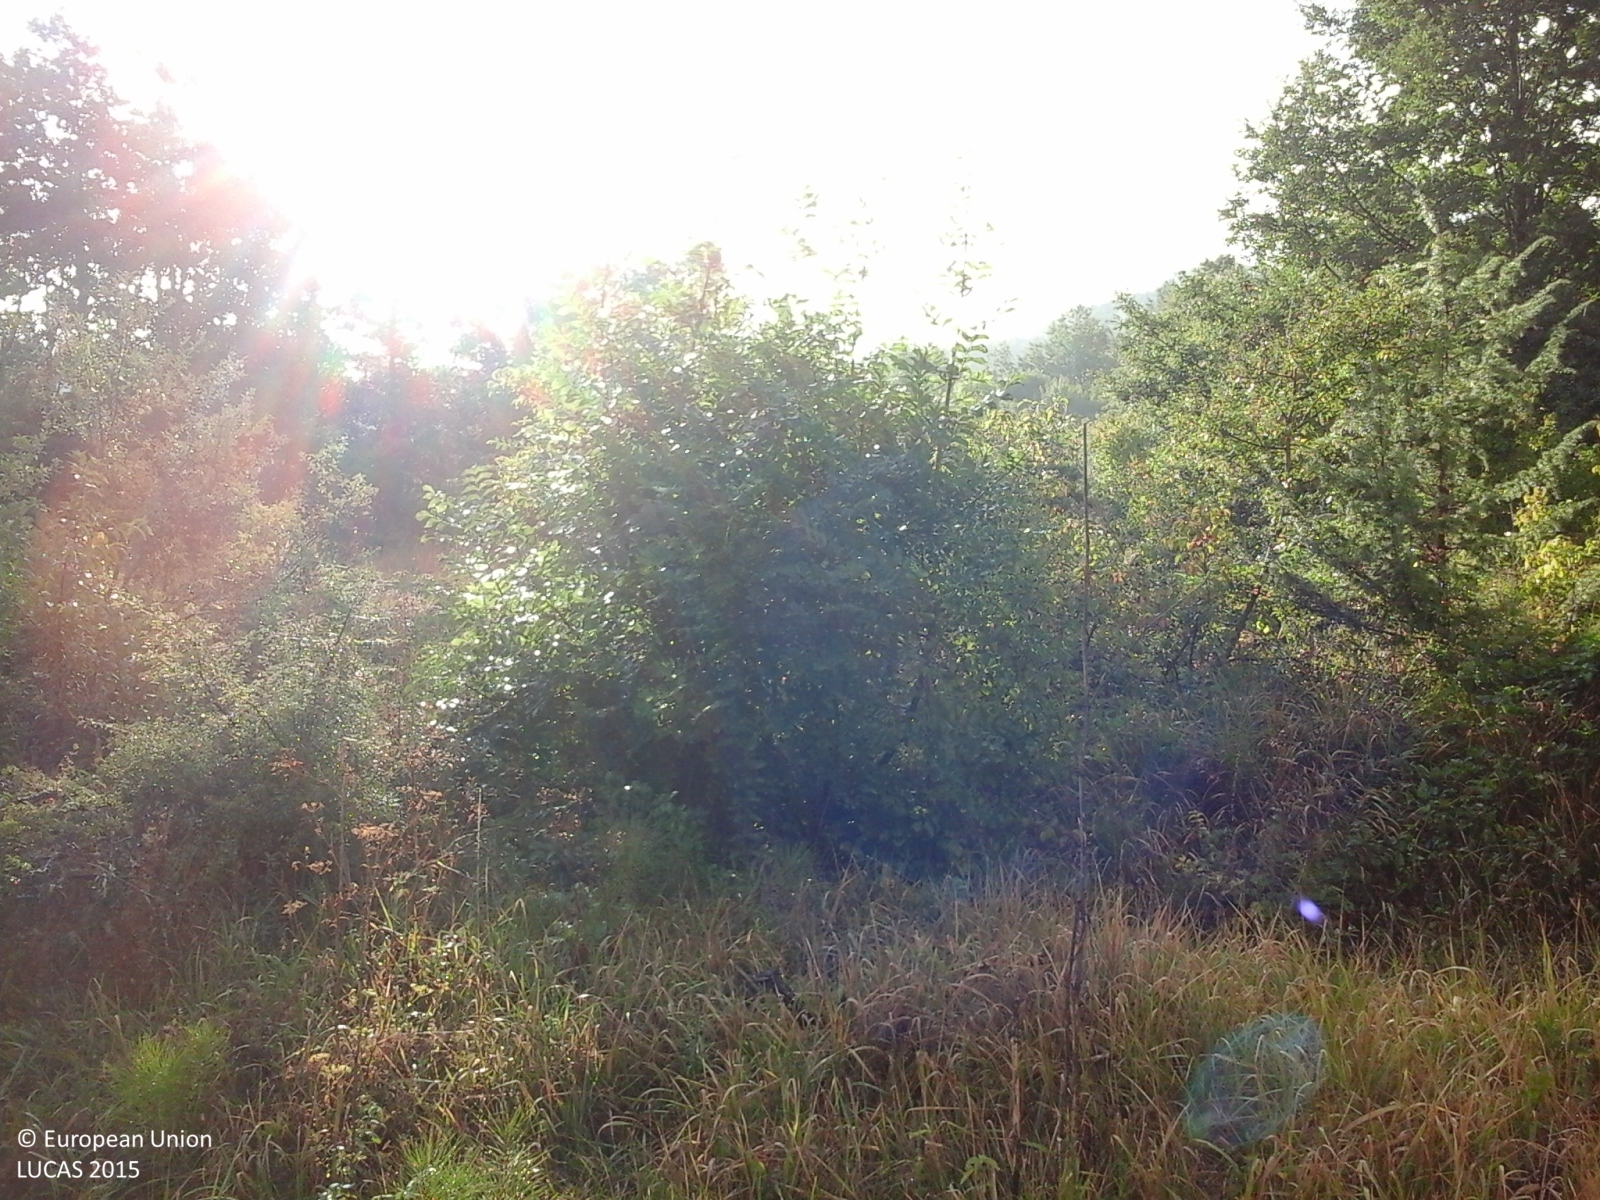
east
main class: Woodland
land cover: Broadleaved woodland
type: thermophilous deciduous forest
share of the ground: > 75 %
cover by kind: broadleaved forest trees 75 %, shrubs 15 %, herbaceous plants 10 %
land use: Forestry
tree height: > 5 m
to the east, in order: Broadleaved woodland; Tracks; Broadleaved woodland
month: September
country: IT
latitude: 41.7454
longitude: 14.3741
